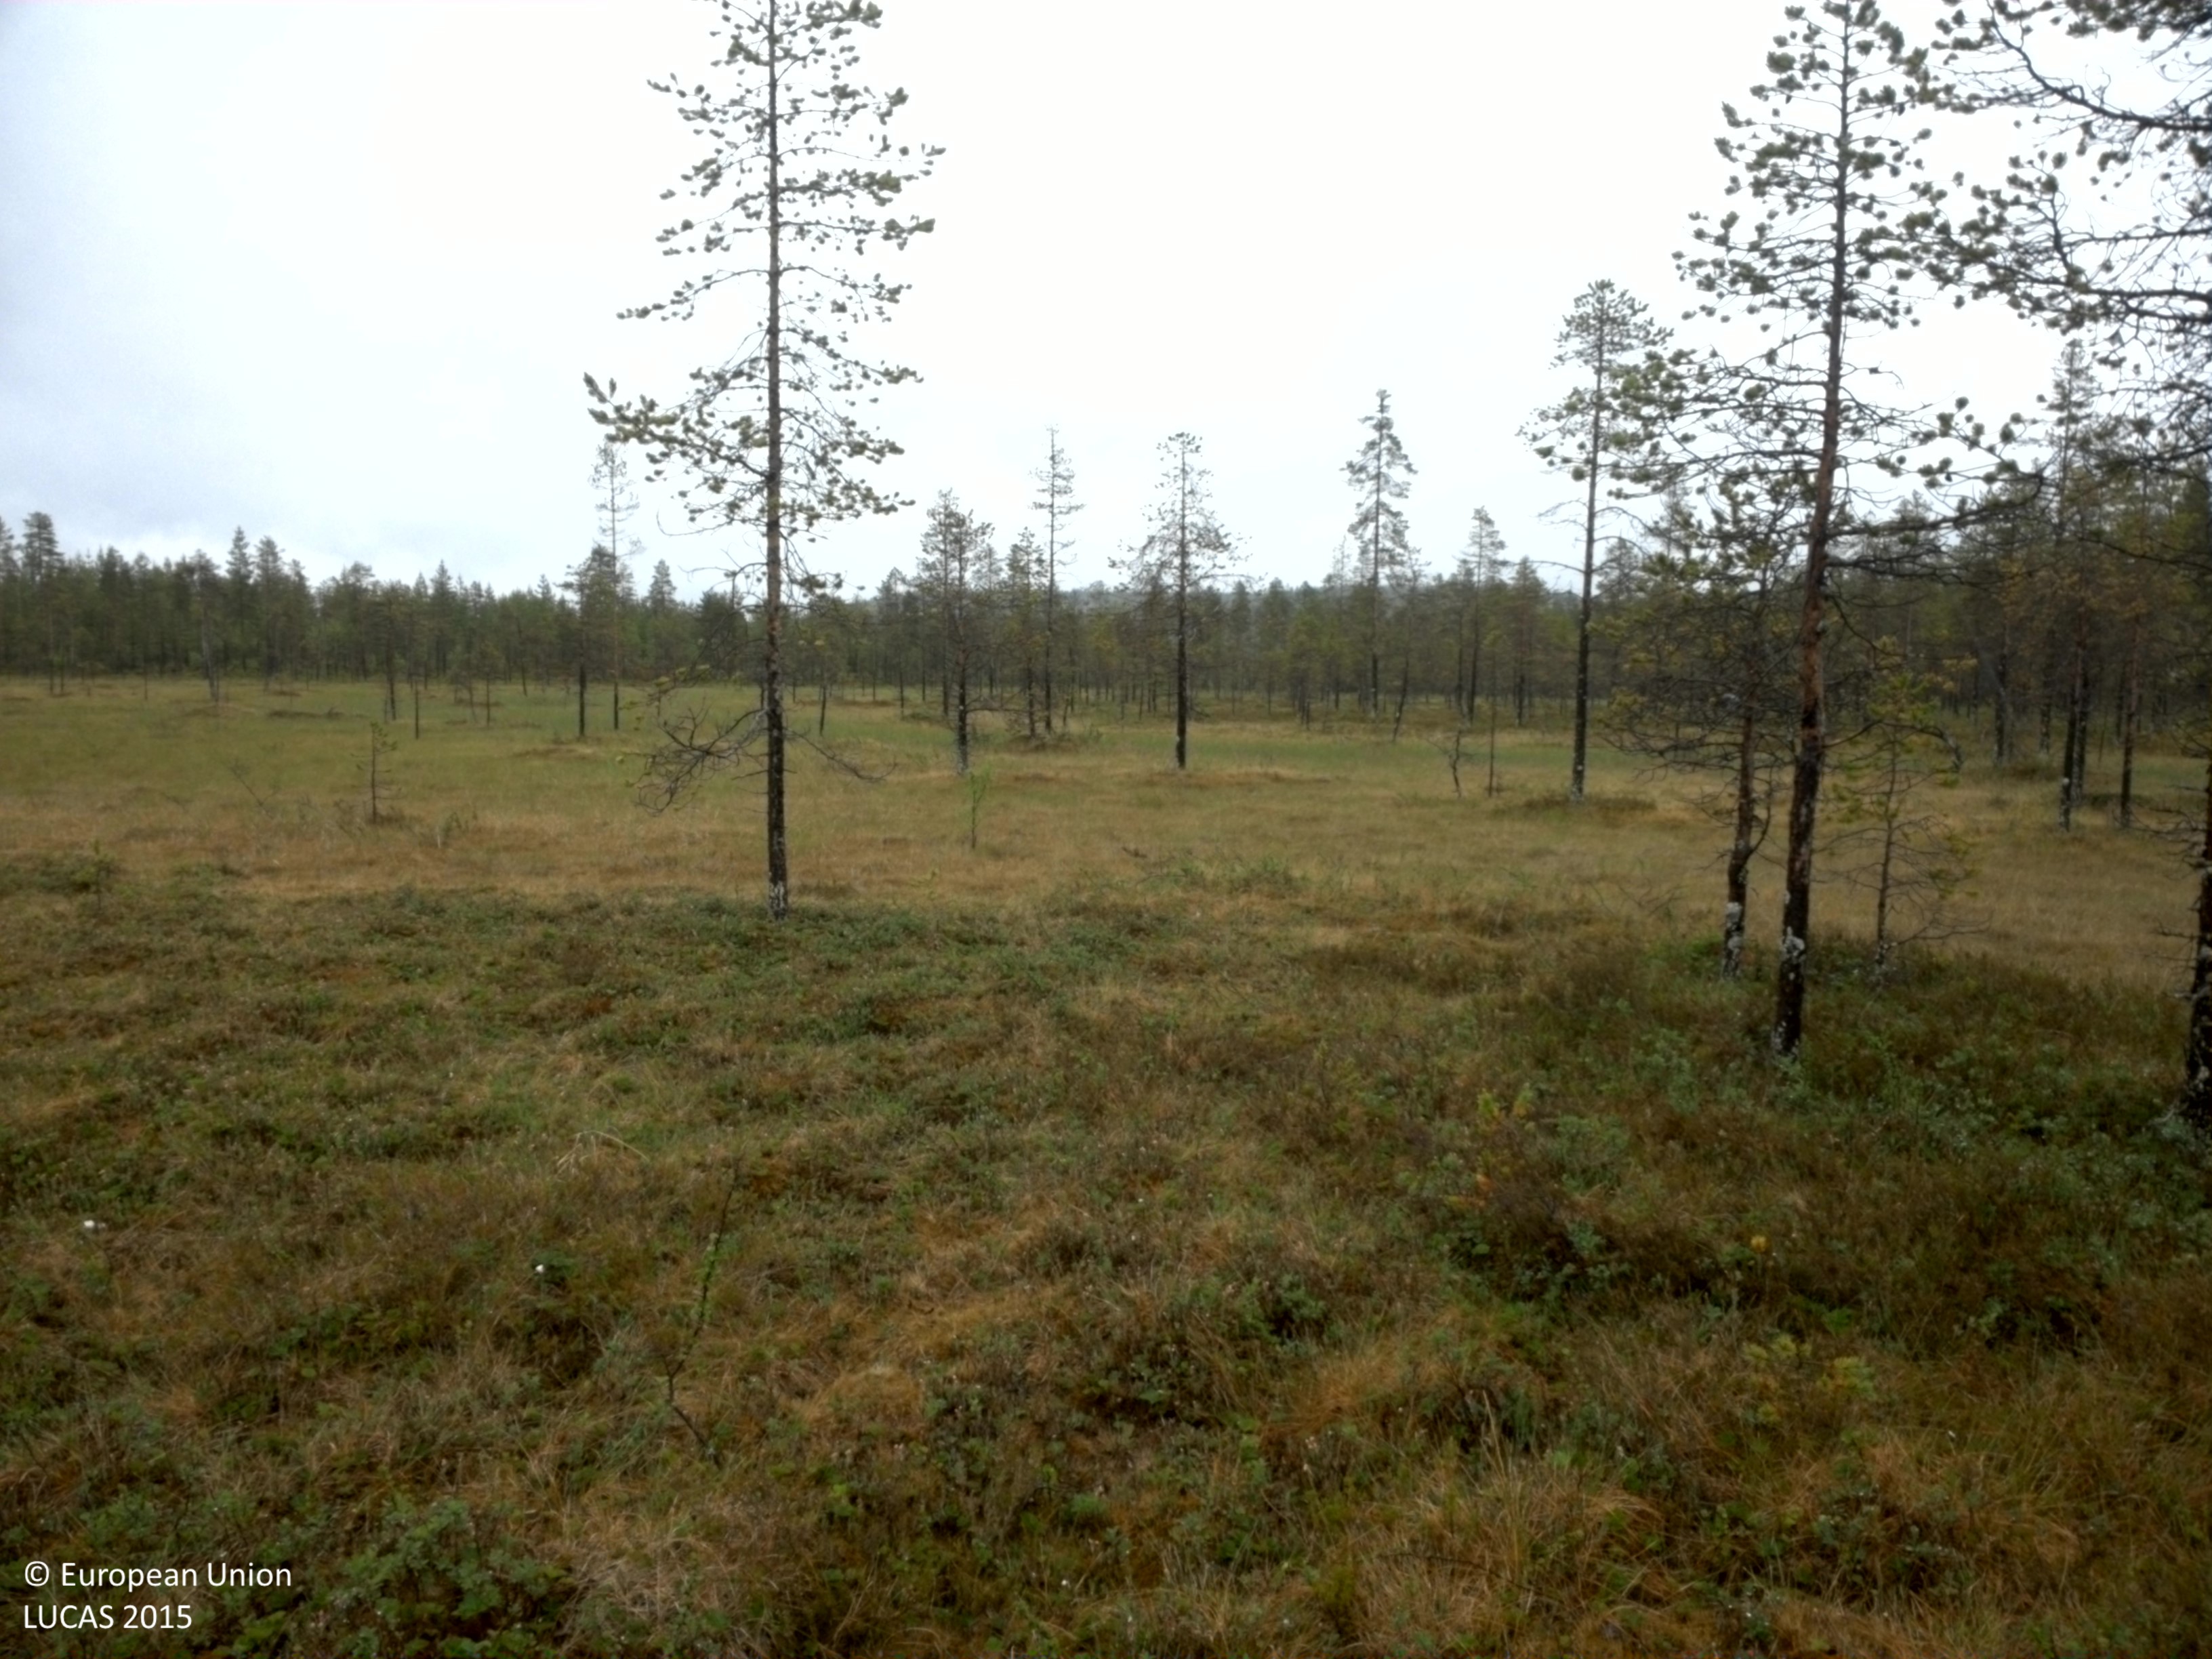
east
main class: Woodland
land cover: Pine dominated coniferous woodland
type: mire and swamp forests
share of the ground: 25 - 50 %
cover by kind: coniferous forest trees 40 %, herbaceous plants 30 %, shrubs 25 %, lichens and mosses 5 %
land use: Forestry
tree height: > 5 m
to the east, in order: Pine dominated coniferous woodland; Peatbogs; Pine dominated coniferous woodland; Pine dominated mixed woodland
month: July
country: SE
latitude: 64.6050
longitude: 18.1801
